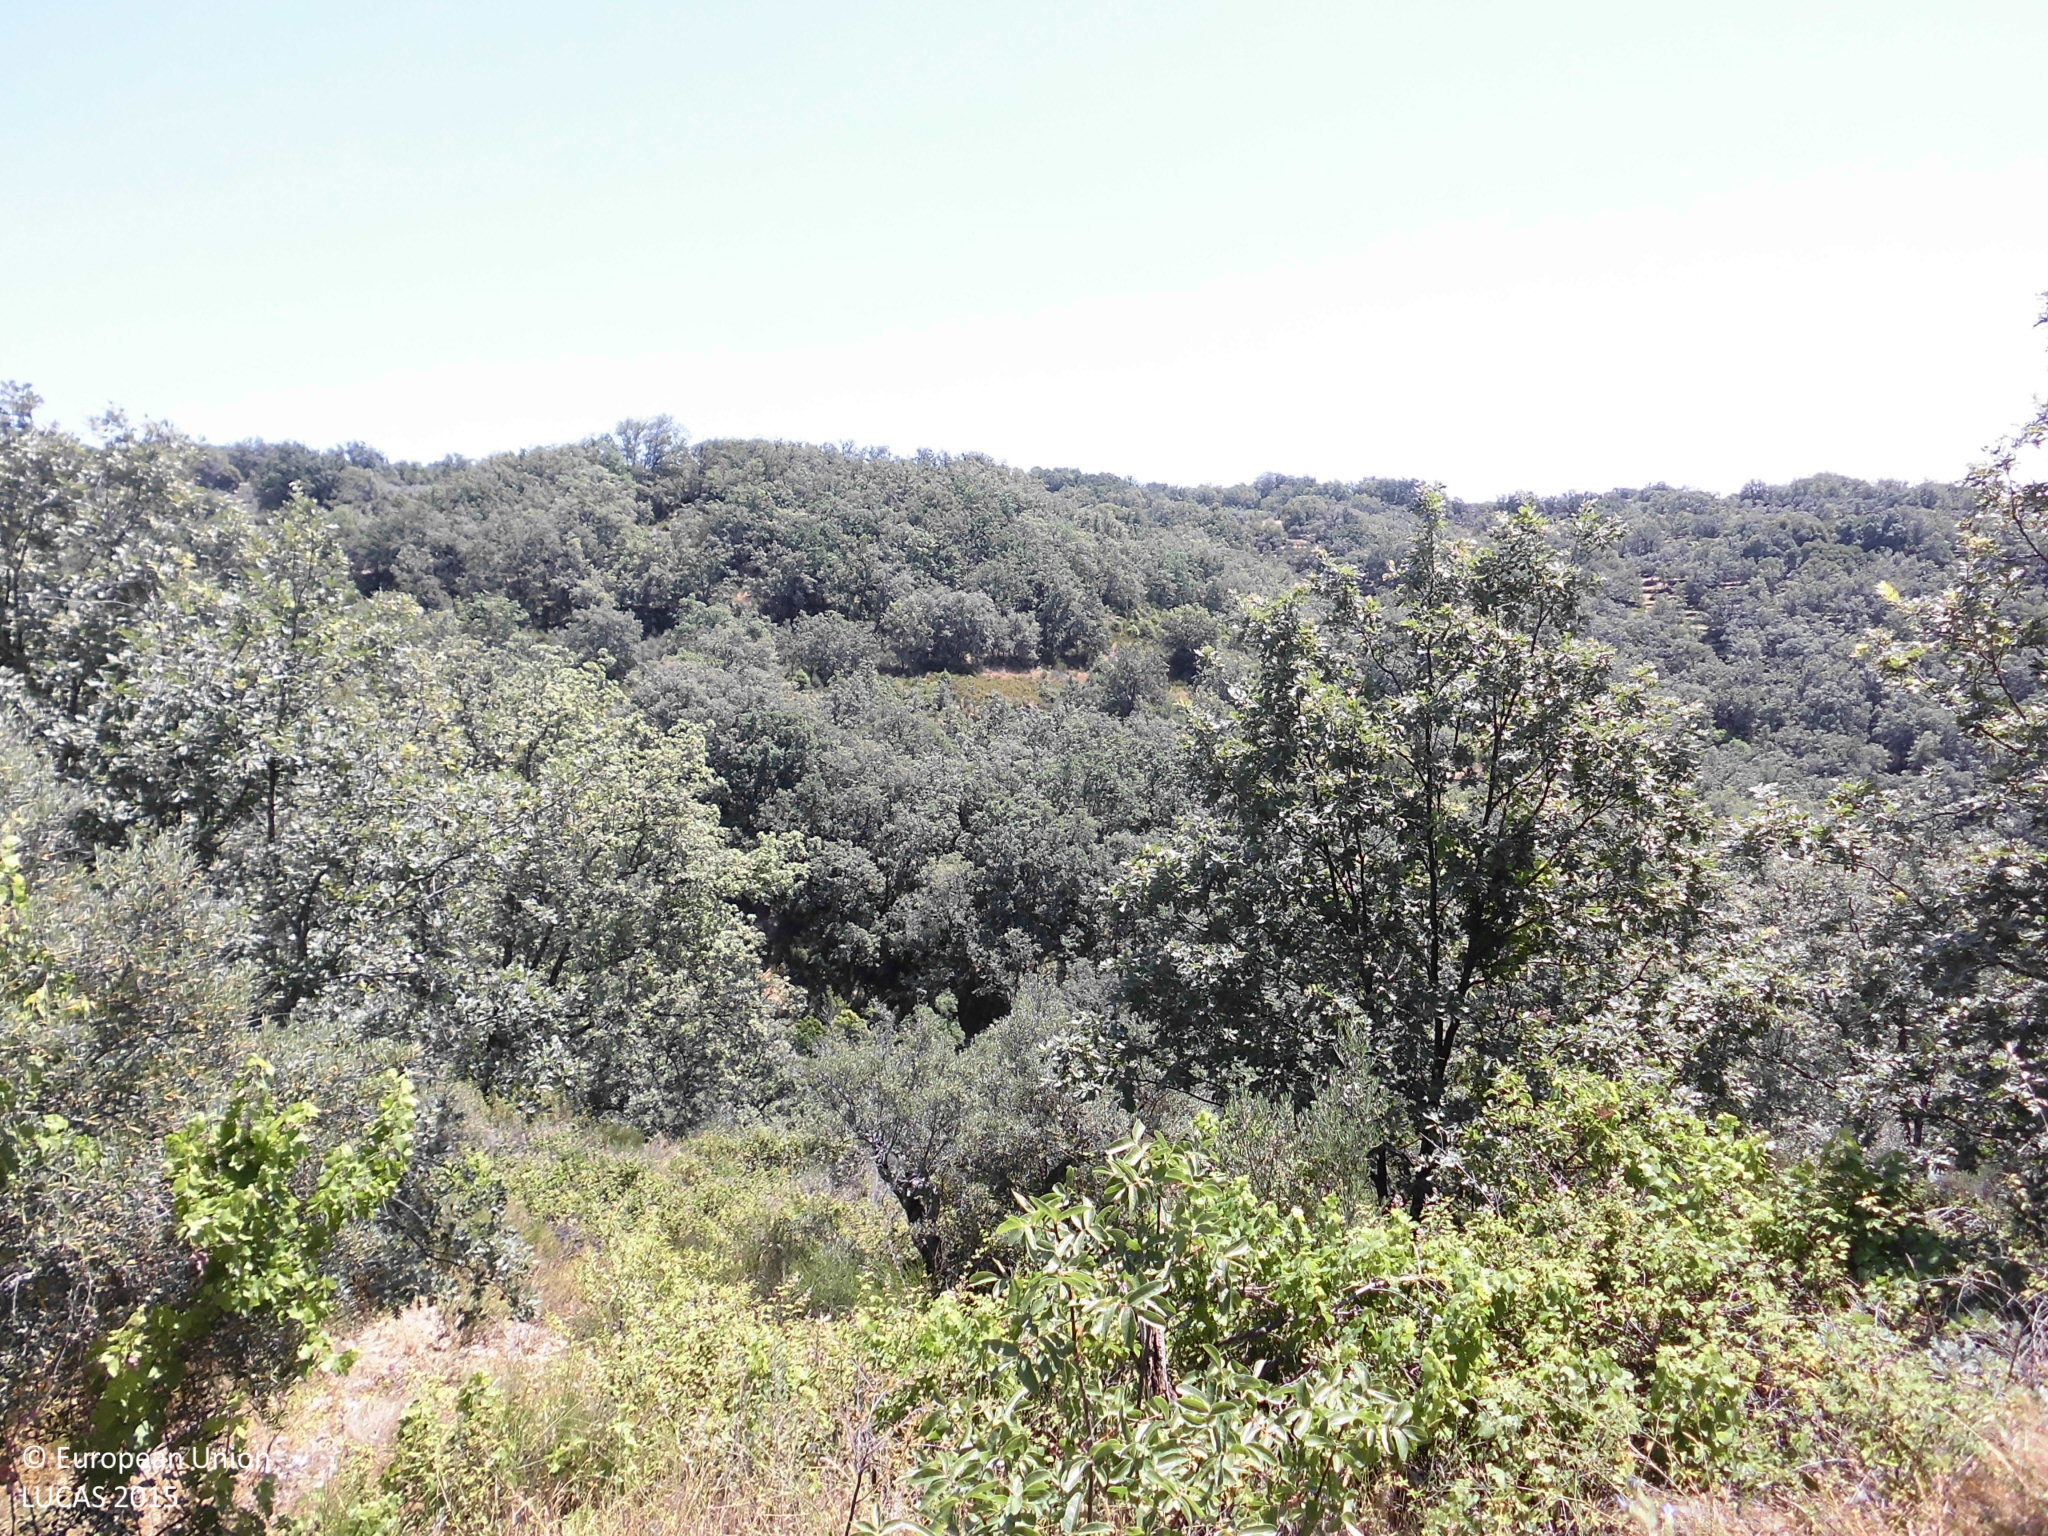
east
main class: Woodland
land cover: Broadleaved woodland
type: broadleaved evergreen forest
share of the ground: 25 - 50 %
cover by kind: herbaceous plants 55 %, broadleaved forest trees 35 %, shrubs 10 %
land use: Forestry
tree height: > 5 m
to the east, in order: Broadleaved woodland; Rivers and streams; Broadleaved woodland
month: June
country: ES
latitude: 40.1059
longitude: -5.5358
